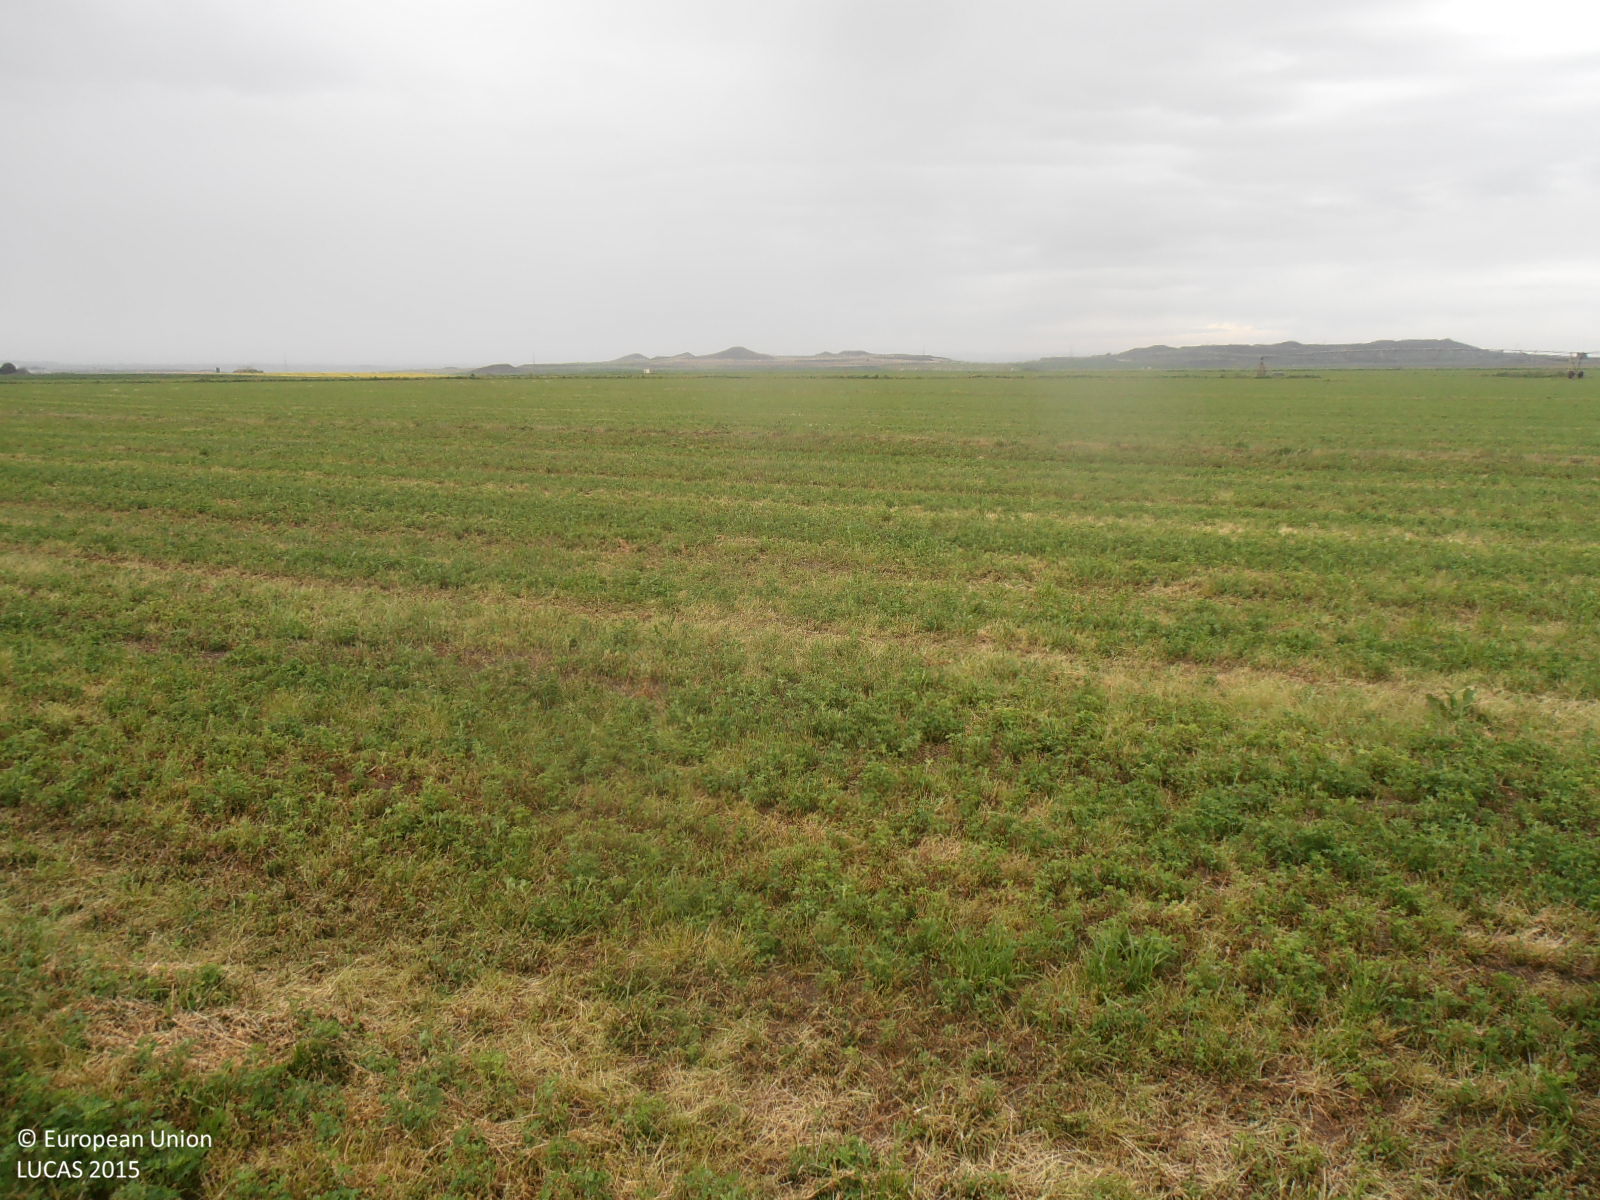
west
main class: Cropland
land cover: Lucerne
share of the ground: > 75 %
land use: Agriculture (excluding fallow land and kitchen gardens)
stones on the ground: < 10 %
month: April
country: ES
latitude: 41.4420
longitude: -0.4175
